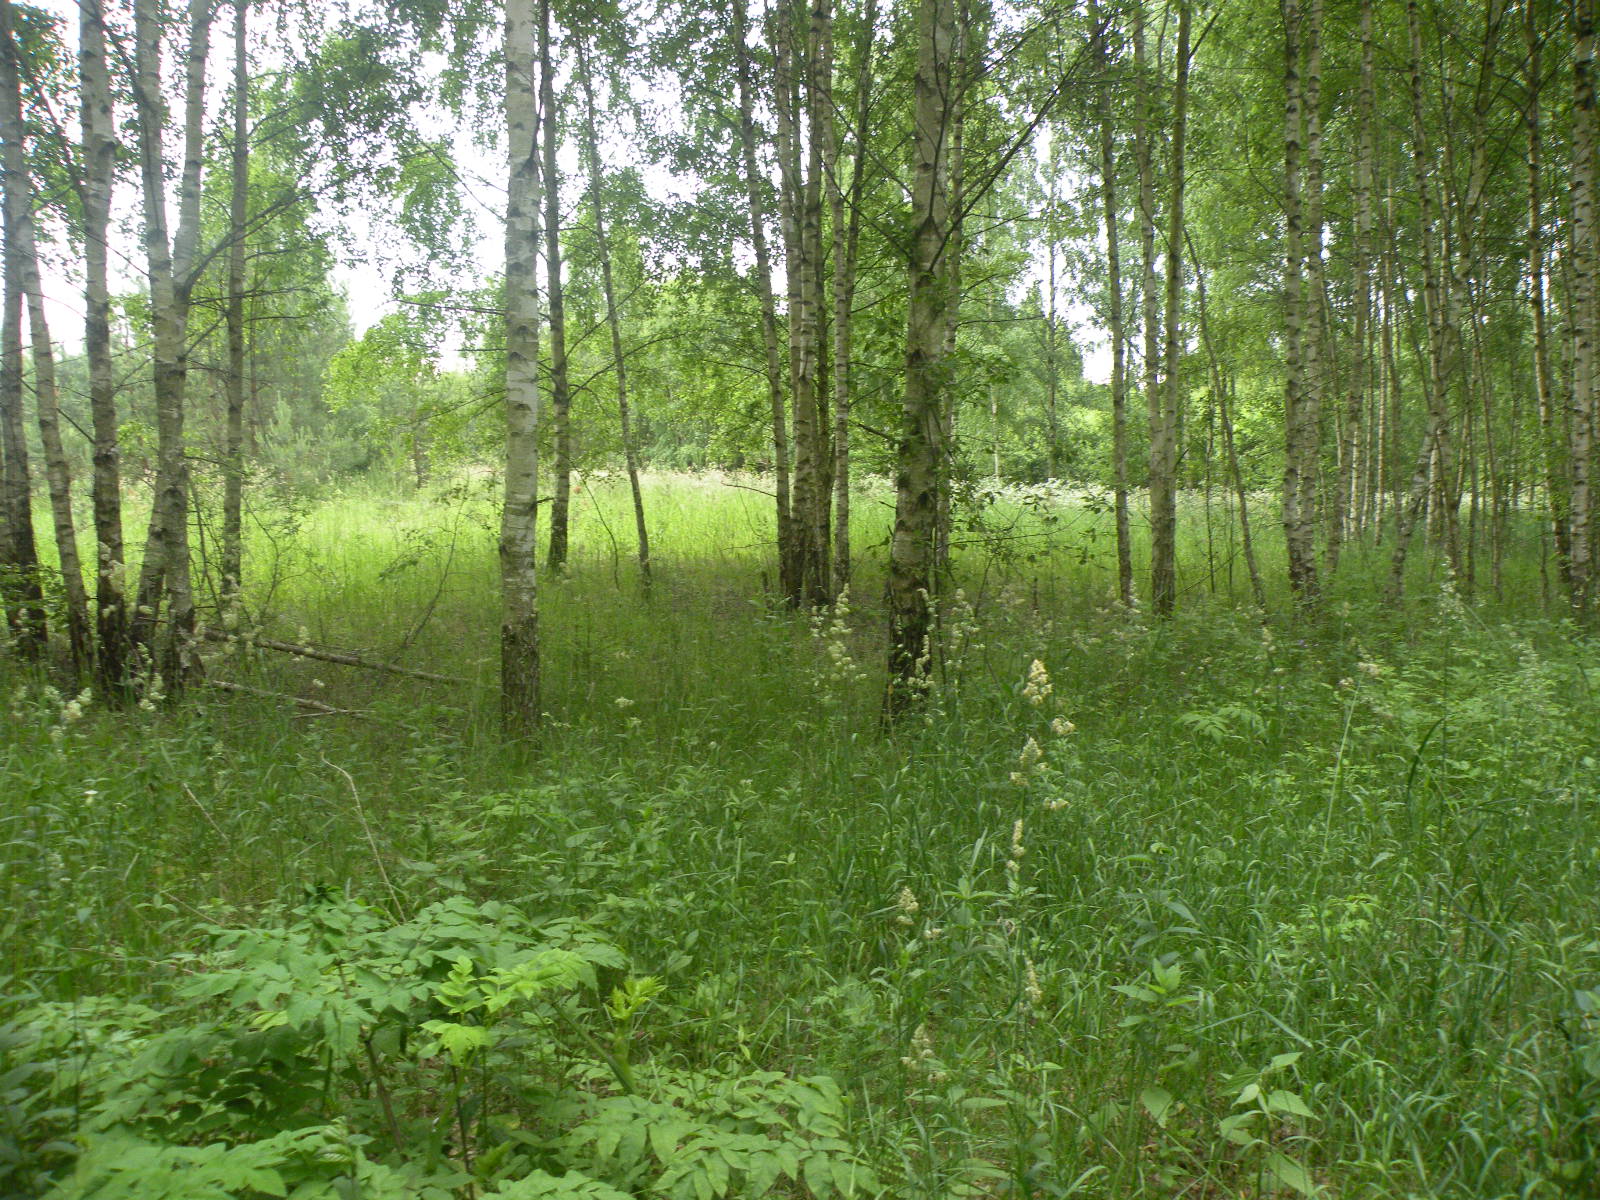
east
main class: Woodland
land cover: Broadleaved woodland
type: non-riverine alder, birch or aspen forest
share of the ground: 50 - 75 %
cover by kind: broadleaved forest trees 60 %, herbaceous plants 35 %, shrubs 5 %
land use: Forestry
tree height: > 5 m
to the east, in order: Broadleaved woodland; Spontaneously vegetated surfaces; Grassland with sparse tree/shrub cover; Broadleaved woodland; Spontaneously vegetated surfaces; Tracks; Broadleaved woodland; Grassland without tree/shrub cover; Broadleaved woodland; Shrubland without tree cover; Potatoes; Grassland without tree/shrub cover; Broadleaved woodland
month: June
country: LV
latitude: 55.9604
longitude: 26.7364
